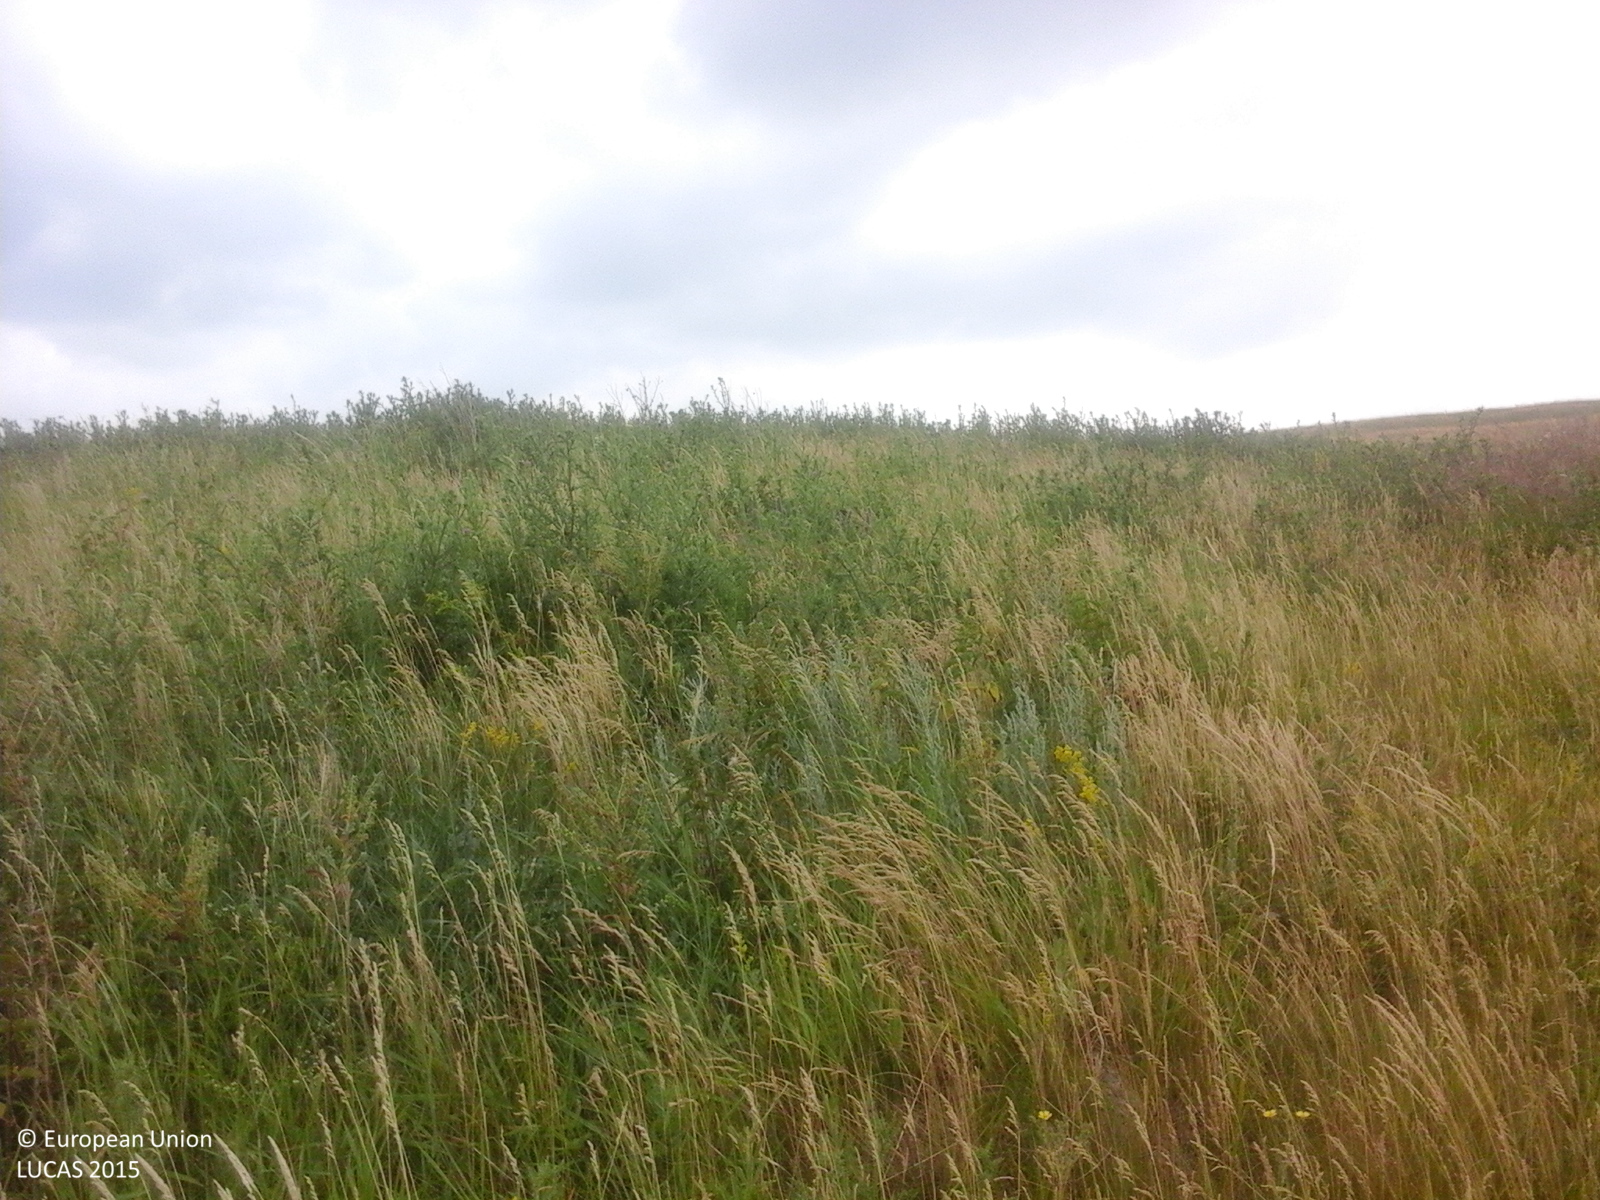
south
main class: Grassland
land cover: Grassland without tree/shrub cover
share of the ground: > 75 %
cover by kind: herbaceous plants 100 %
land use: Agriculture (excluding fallow land and kitchen gardens)
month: June
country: RO
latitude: 47.8722
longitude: 26.7159
